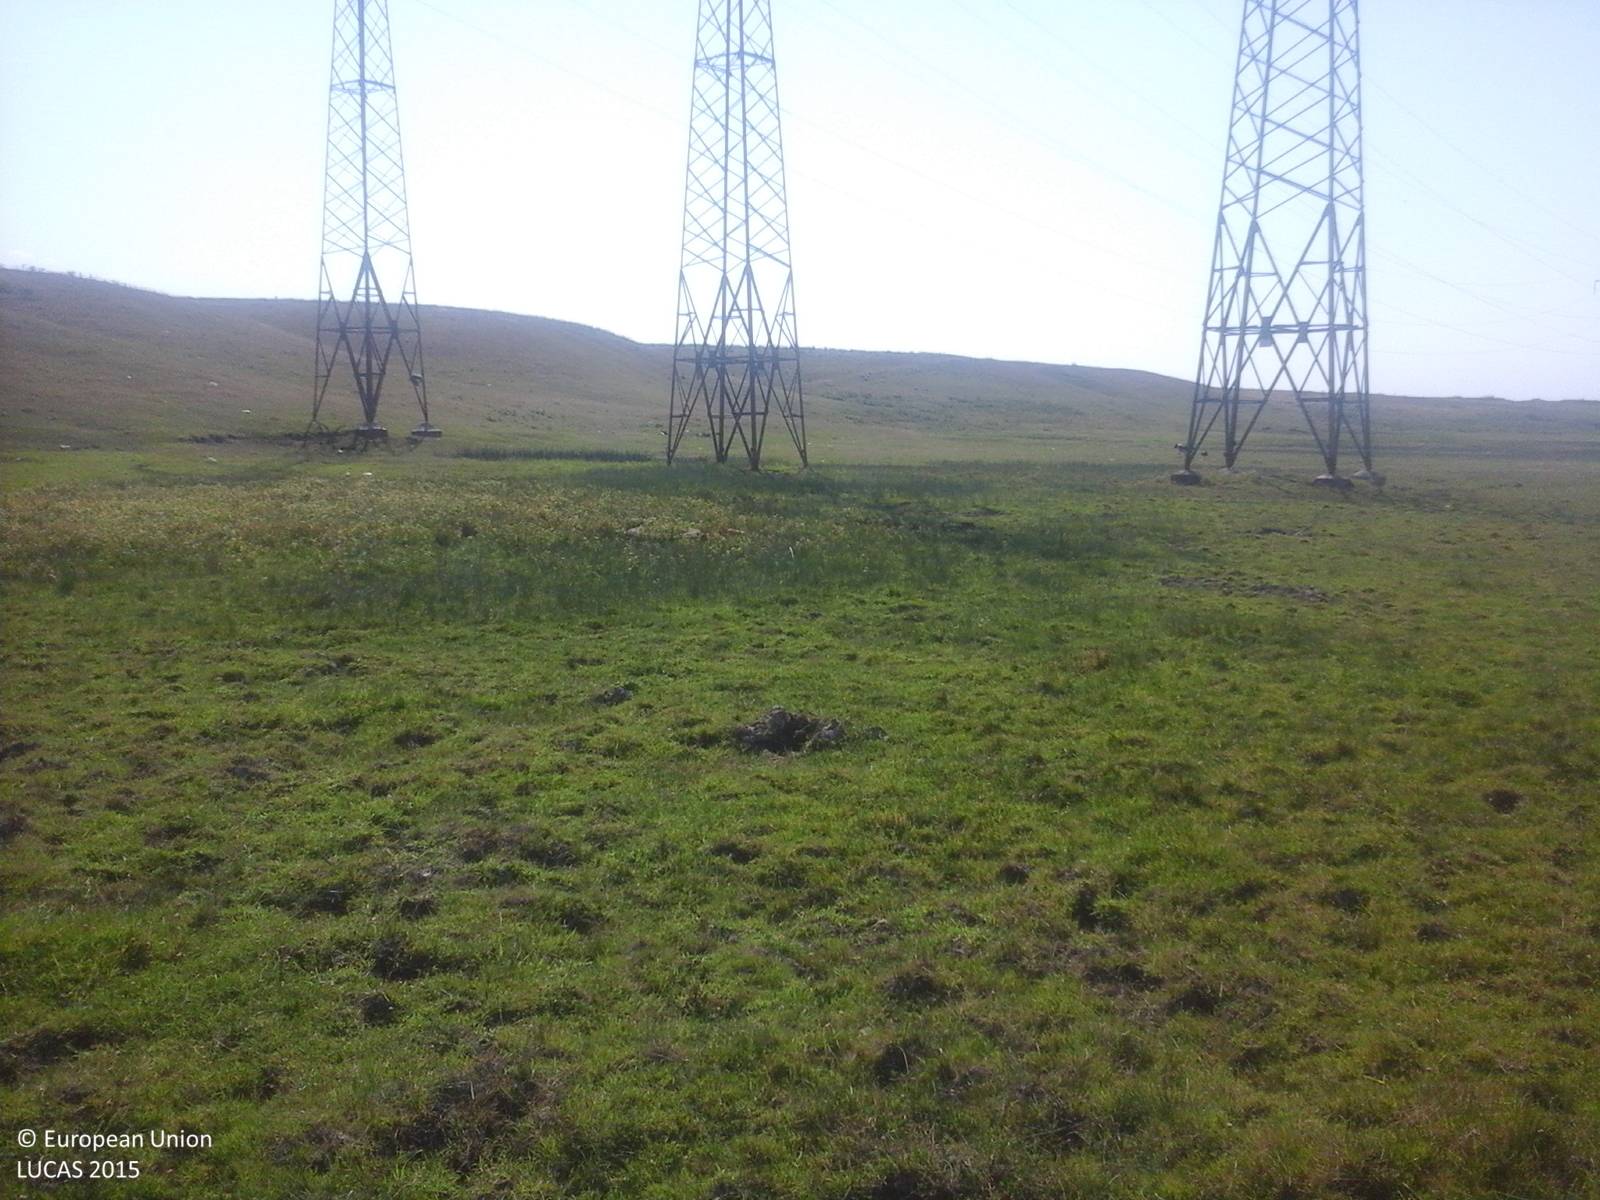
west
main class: Grassland
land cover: Grassland without tree/shrub cover
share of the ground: > 75 %
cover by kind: herbaceous plants 90 %, unconsolidated bare surface 10 %
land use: Agriculture (excluding fallow land and kitchen gardens)
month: July
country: RO
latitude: 44.9023
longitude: 27.6671
